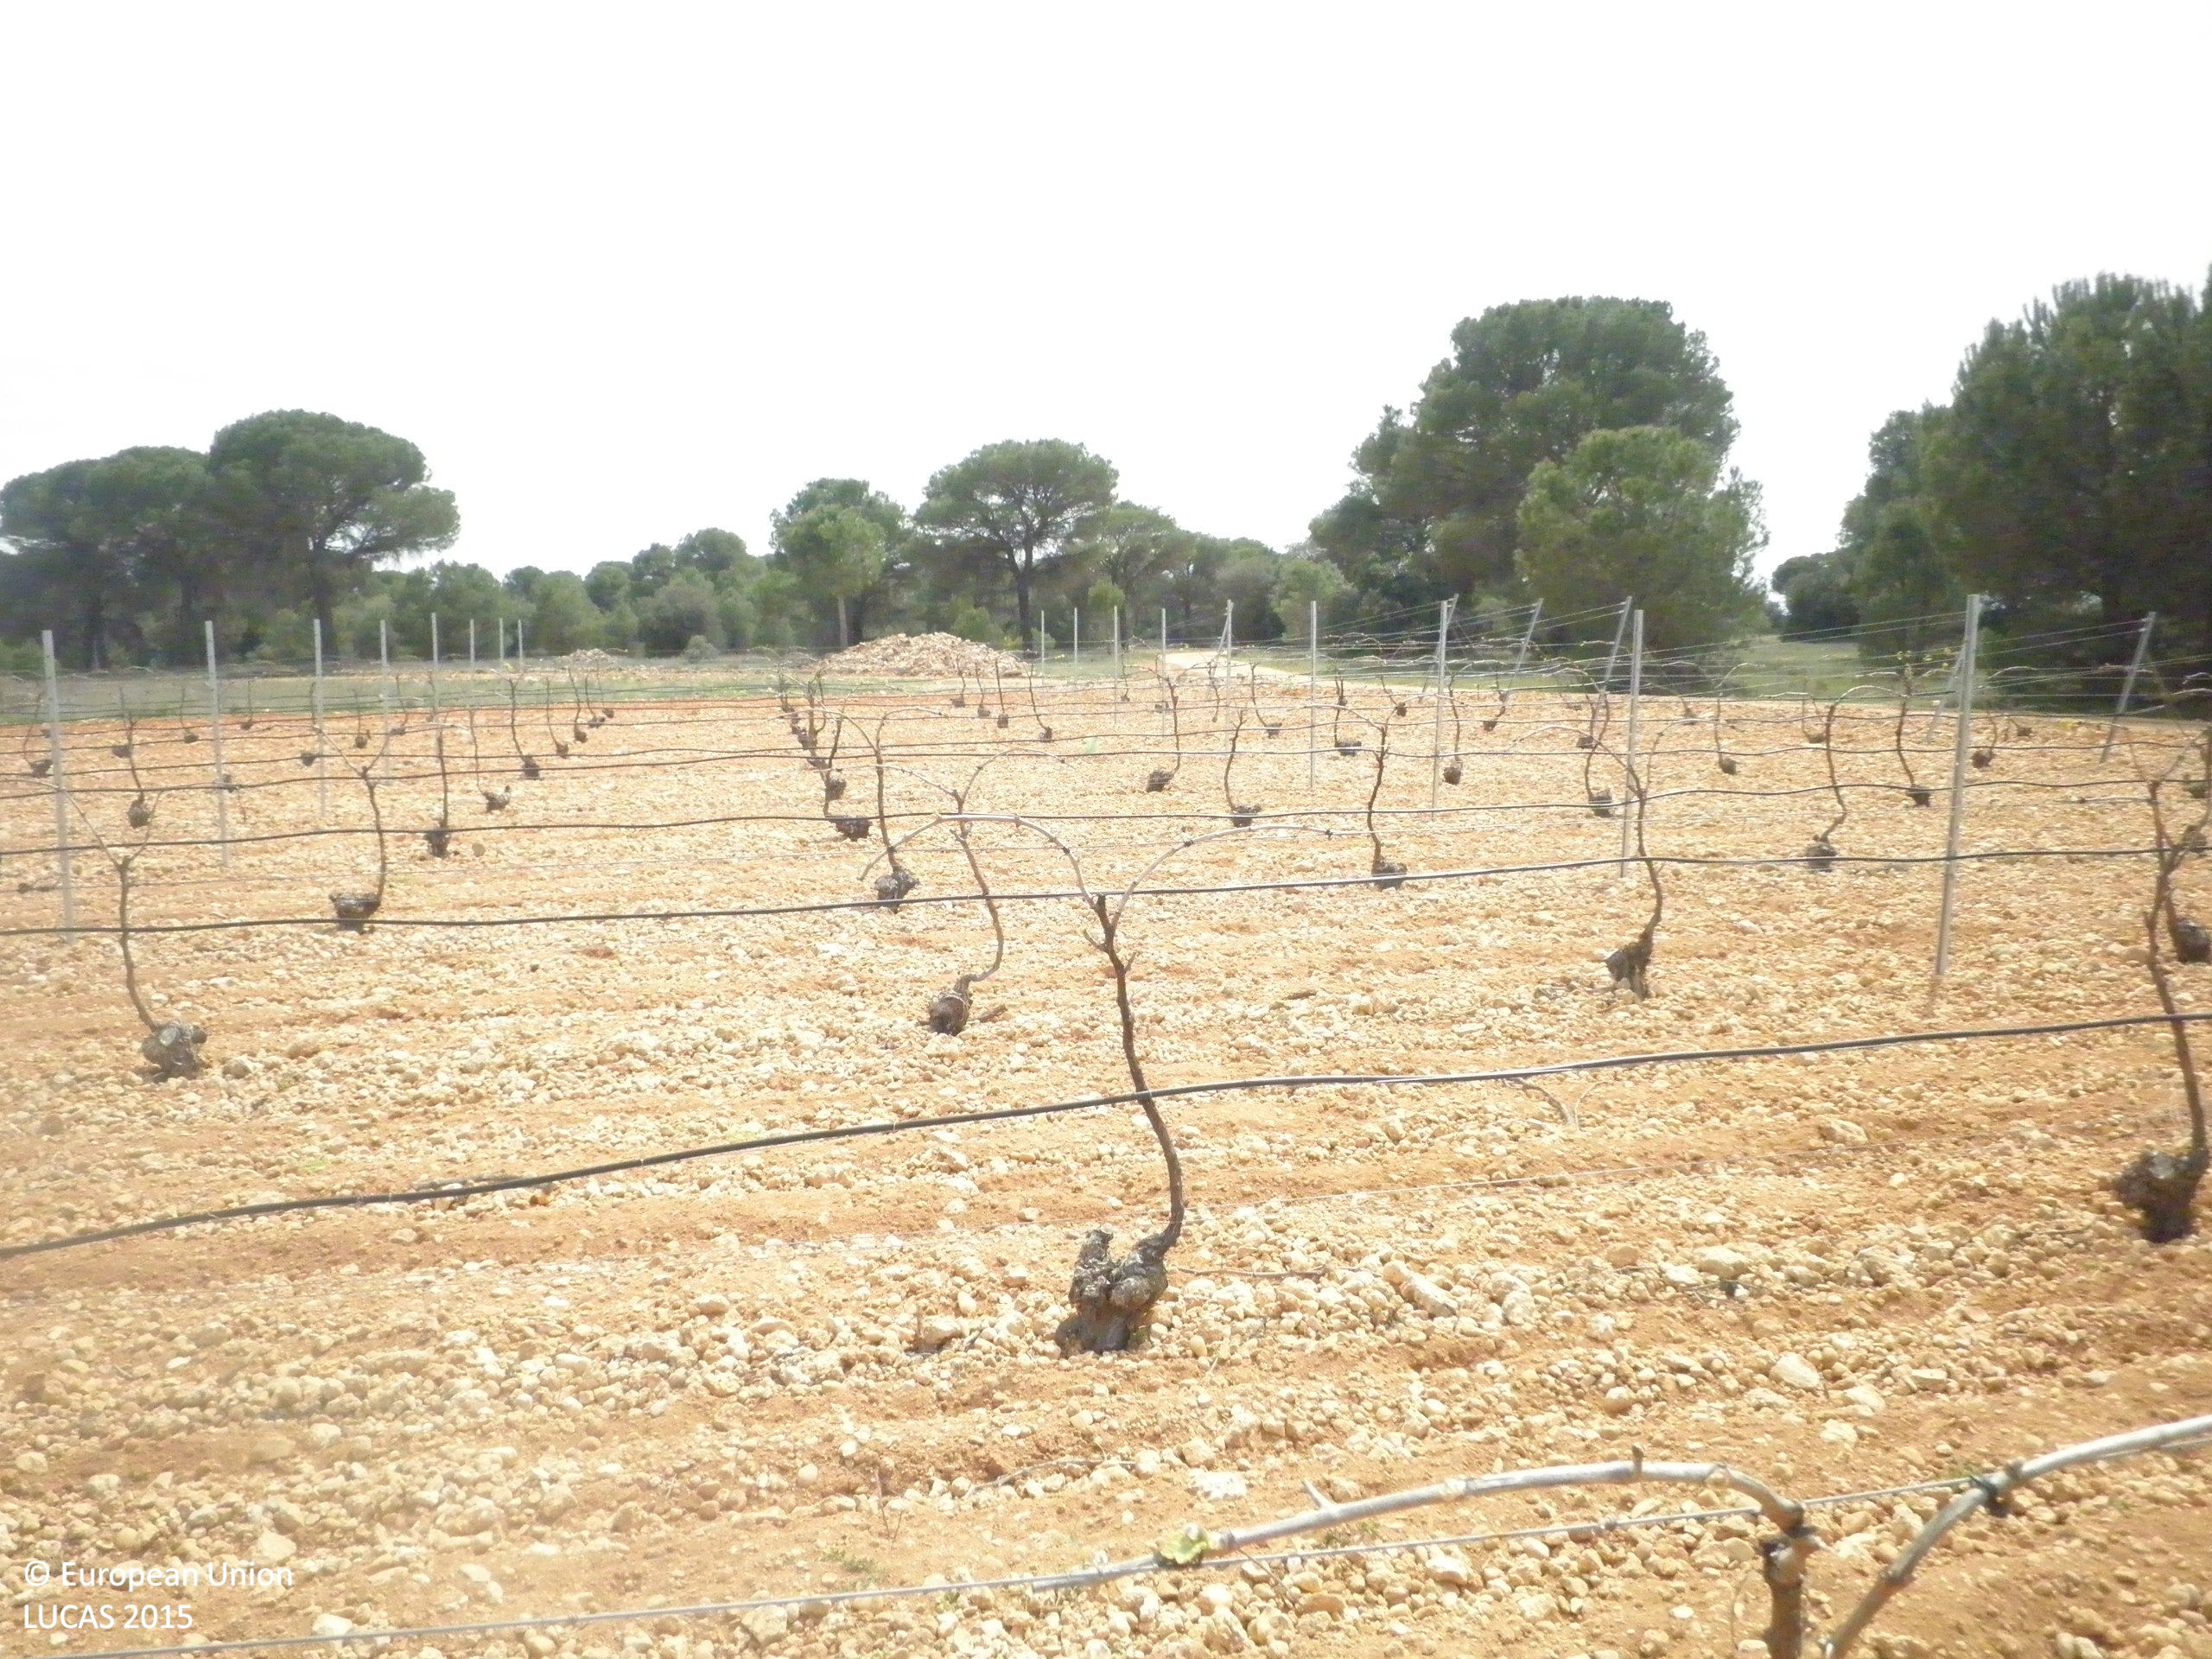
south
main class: Cropland
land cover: Vineyards
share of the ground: < 10 %
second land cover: Other bare soil
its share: > 75 %
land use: Agriculture (excluding fallow land and kitchen gardens)
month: April
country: ES
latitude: 39.4101
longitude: -2.6367
